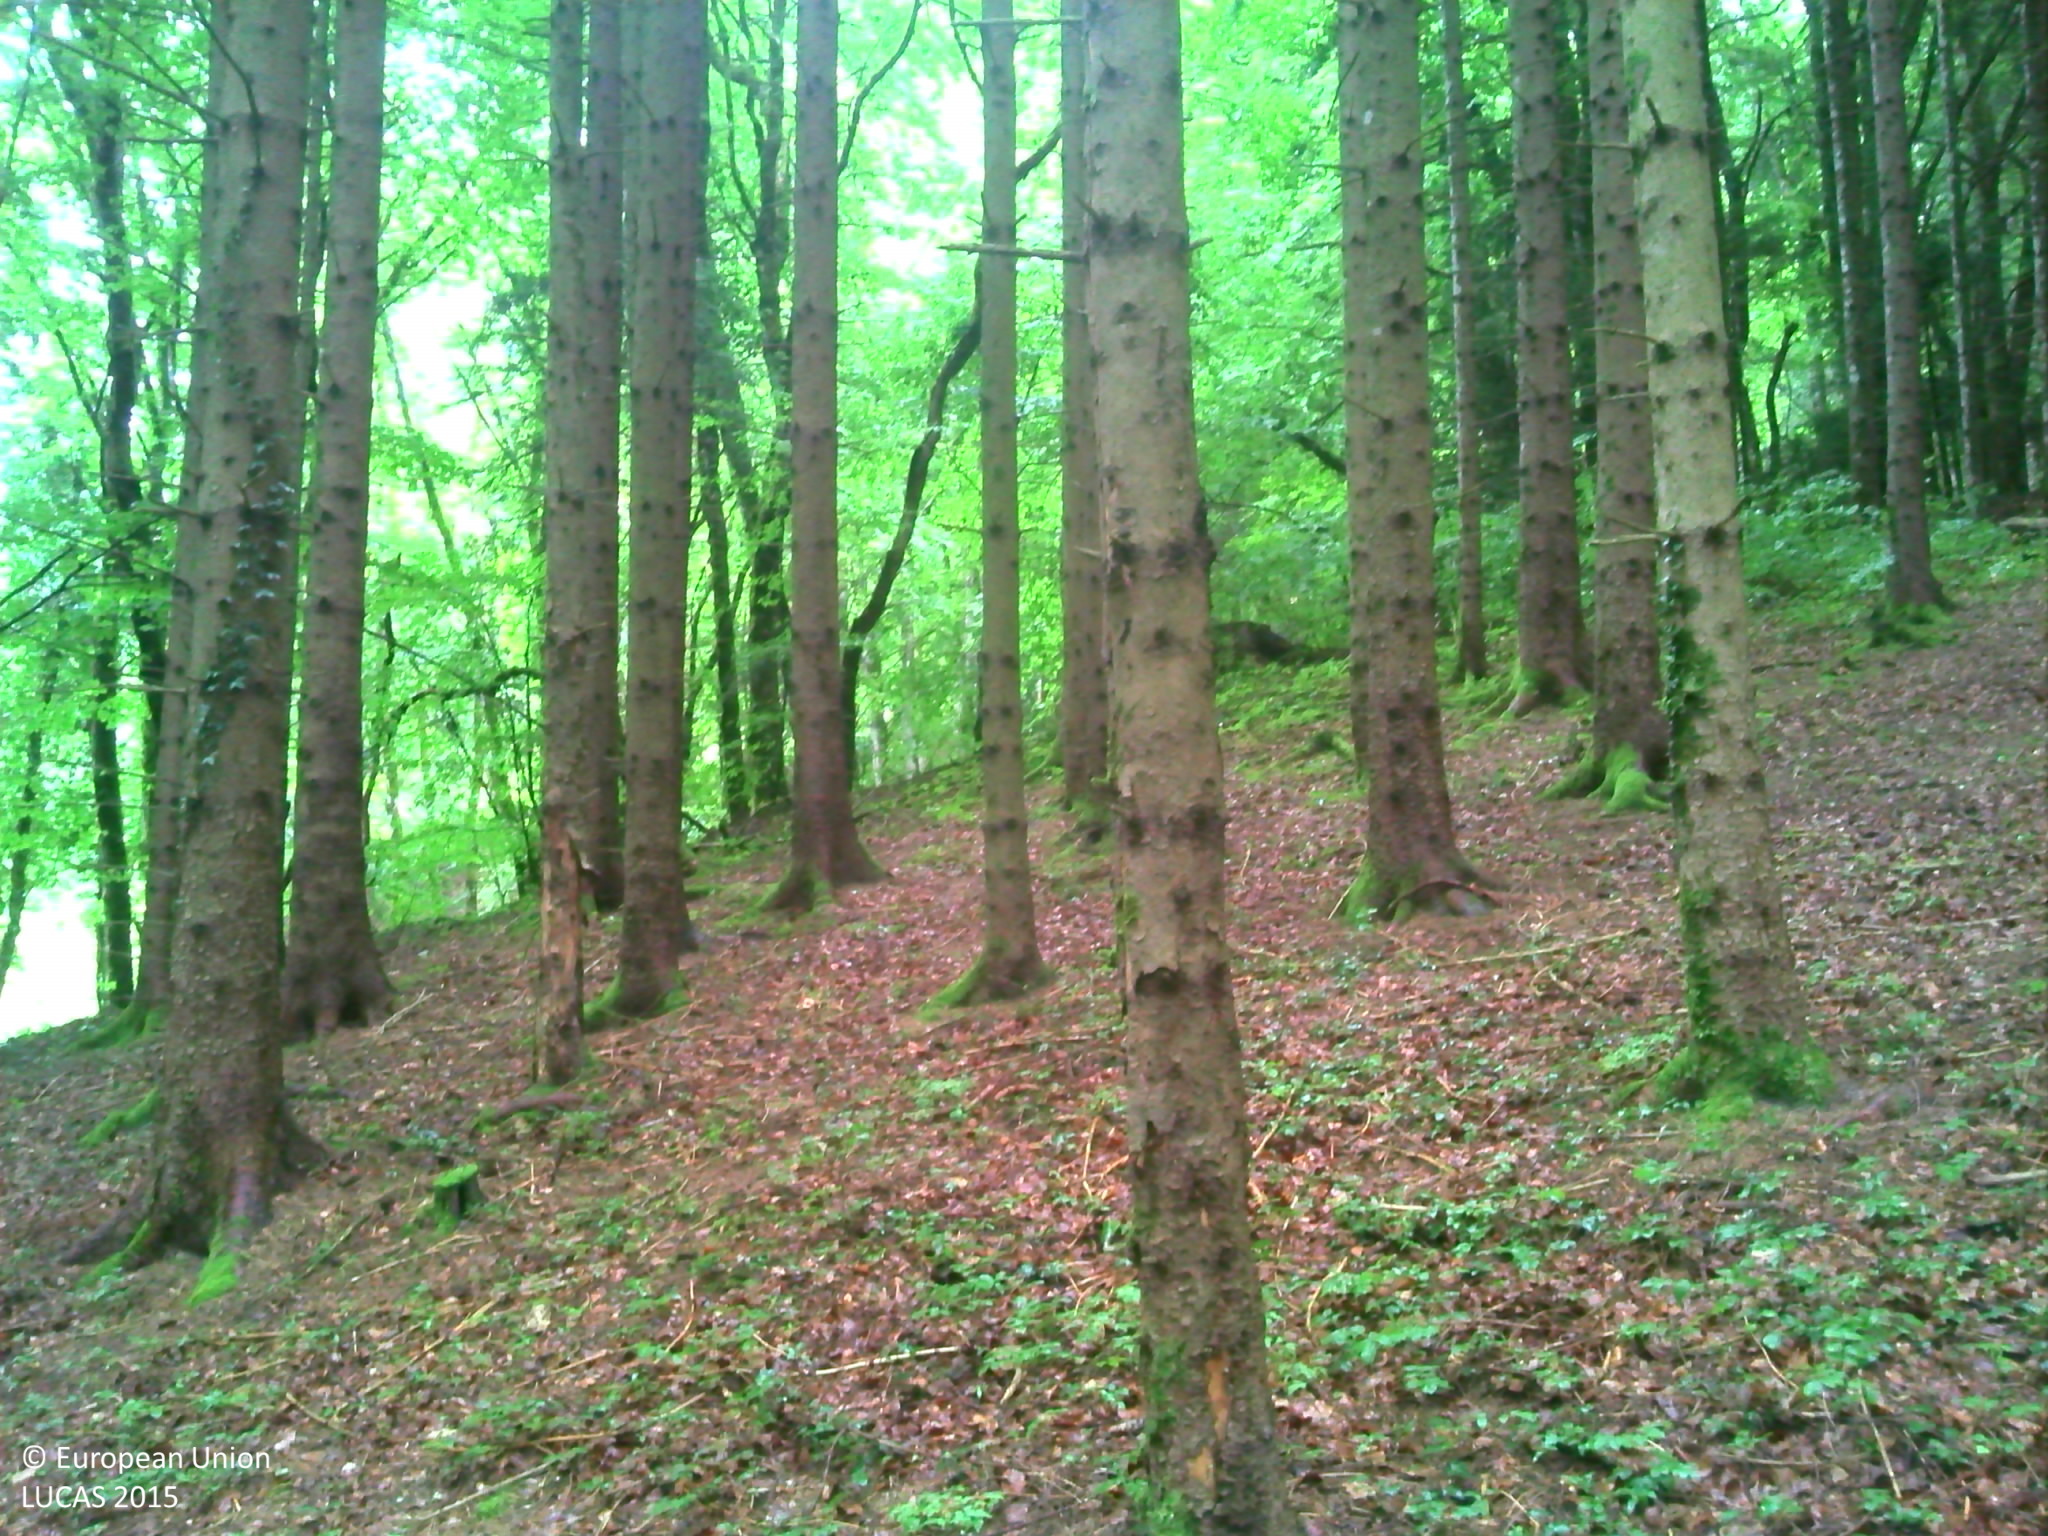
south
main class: Woodland
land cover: Spruce dominated coniferous woodland
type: alpine coniferous forest
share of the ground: > 75 %
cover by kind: coniferous forest trees 70 %, broadleaved forest trees 15 %, herbaceous plants 10 %, lichens and mosses 5 %
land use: Forestry
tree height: > 5 m
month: July
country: FR
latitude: 45.9798
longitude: 6.2735
